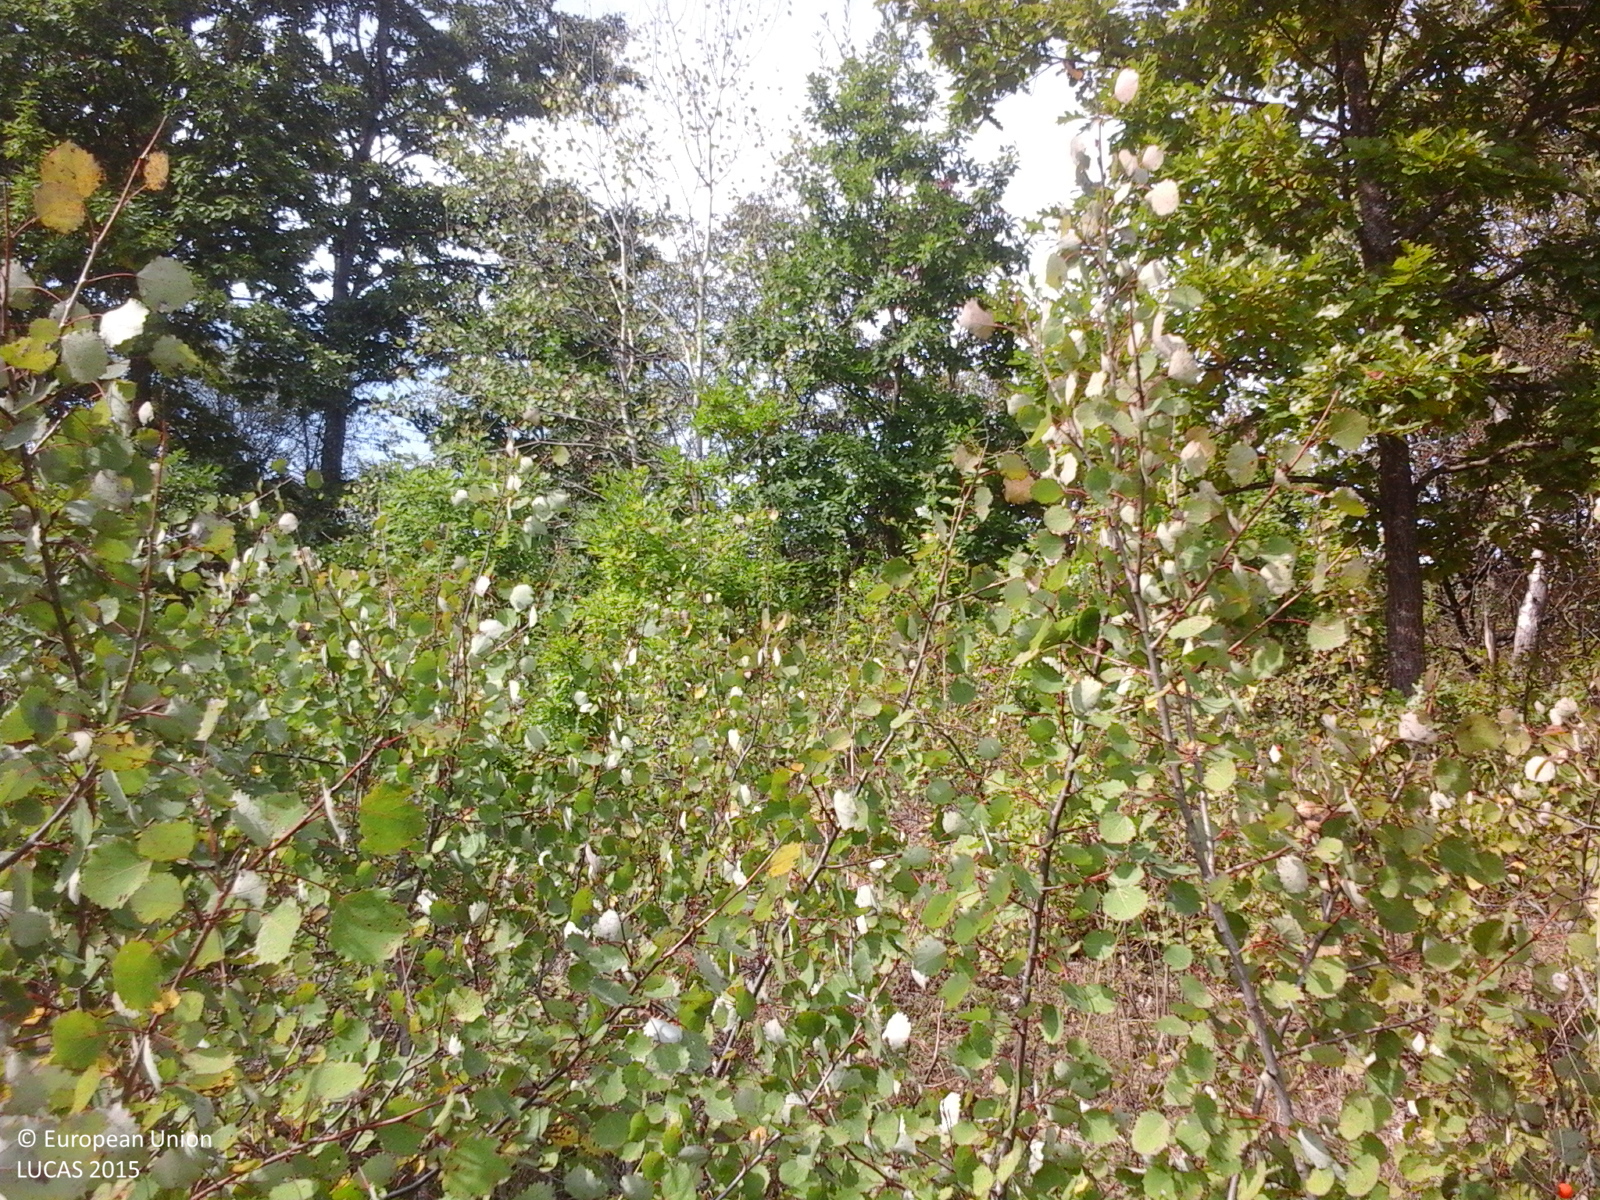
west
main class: Shrubland
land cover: Shrubland with sparse tree cover
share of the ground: > 75 %
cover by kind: herbaceous plants 55 %, shrubs 40 %, broadleaved forest trees 5 %
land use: Fallow land
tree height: < 5 m
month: September
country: RO
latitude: 47.0119
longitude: 23.1532
